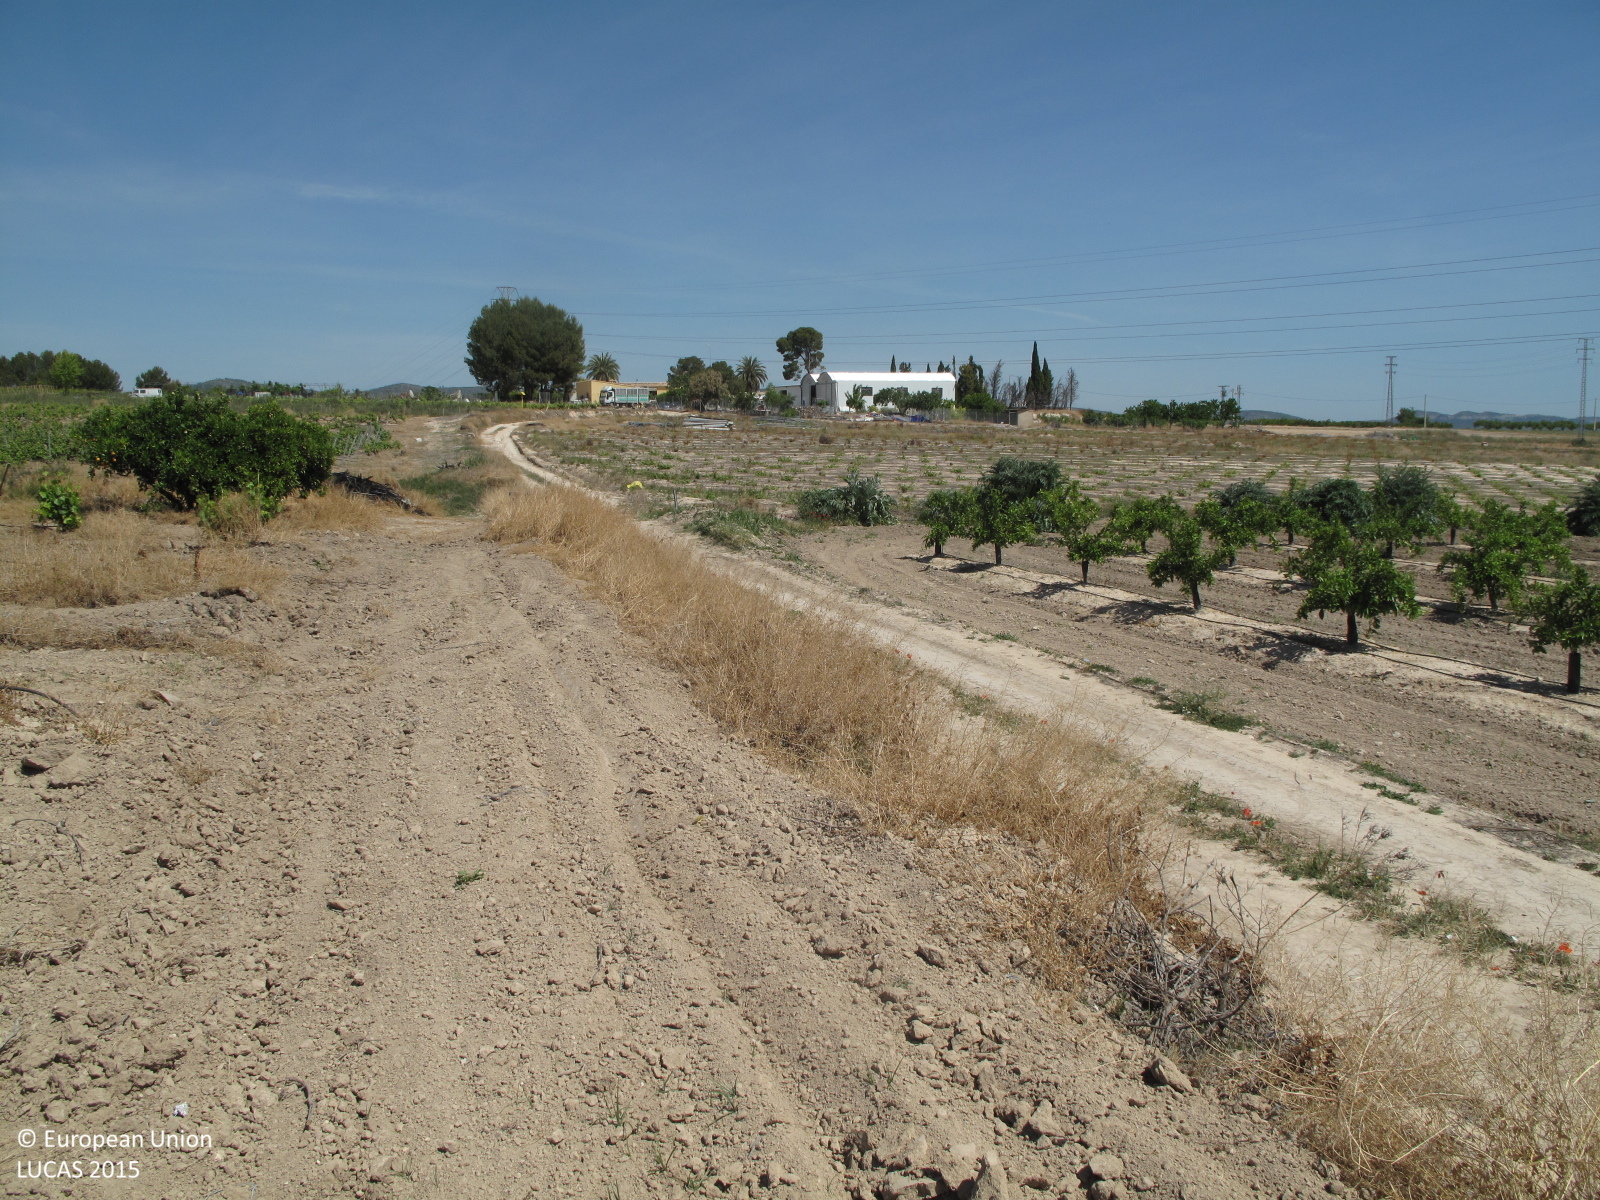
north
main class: Cropland
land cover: Vineyards
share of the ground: 25 - 50 %
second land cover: Other bare soil
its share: > 75 %
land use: Agriculture (excluding fallow land and kitchen gardens)
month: May
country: ES
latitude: 38.8772
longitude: -0.5386
